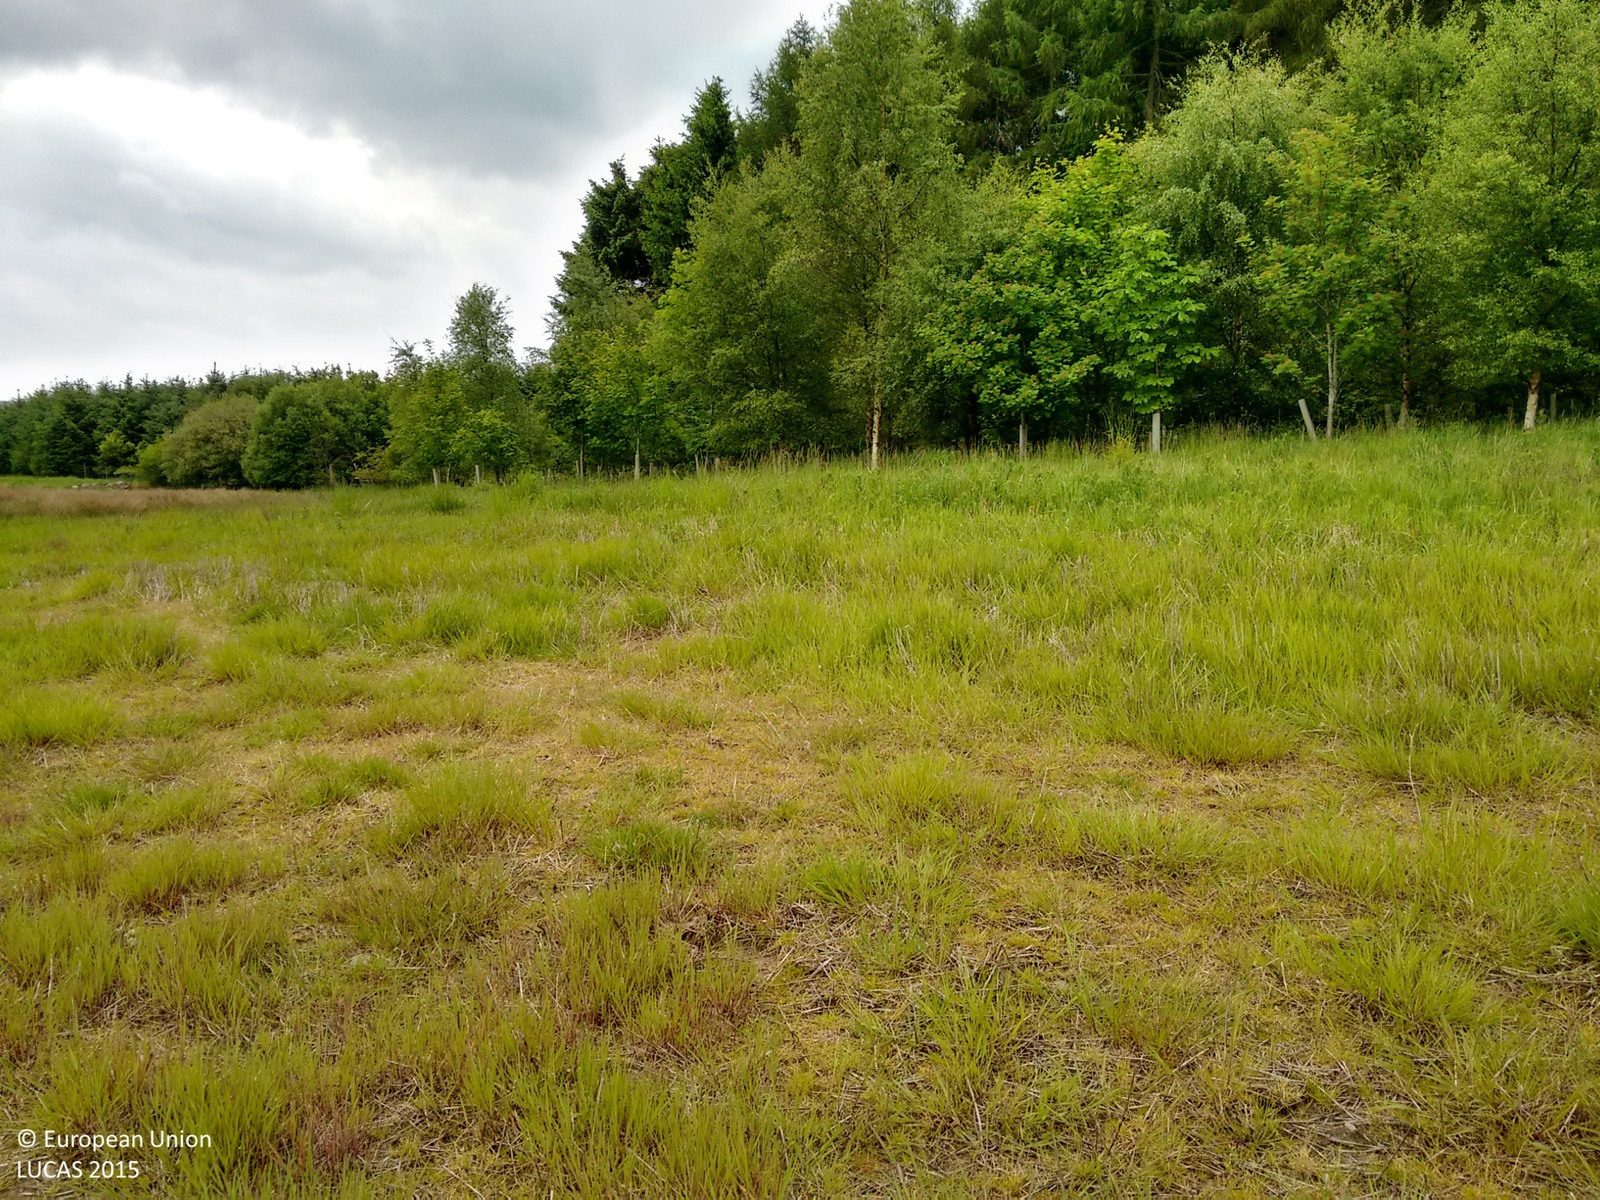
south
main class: Grassland
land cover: Spontaneously vegetated surfaces
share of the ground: > 75 %
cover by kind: herbaceous plants 85 %, unconsolidated bare surface 15 %
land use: Fallow land
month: June
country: GB
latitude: 56.4524
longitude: -3.3609
